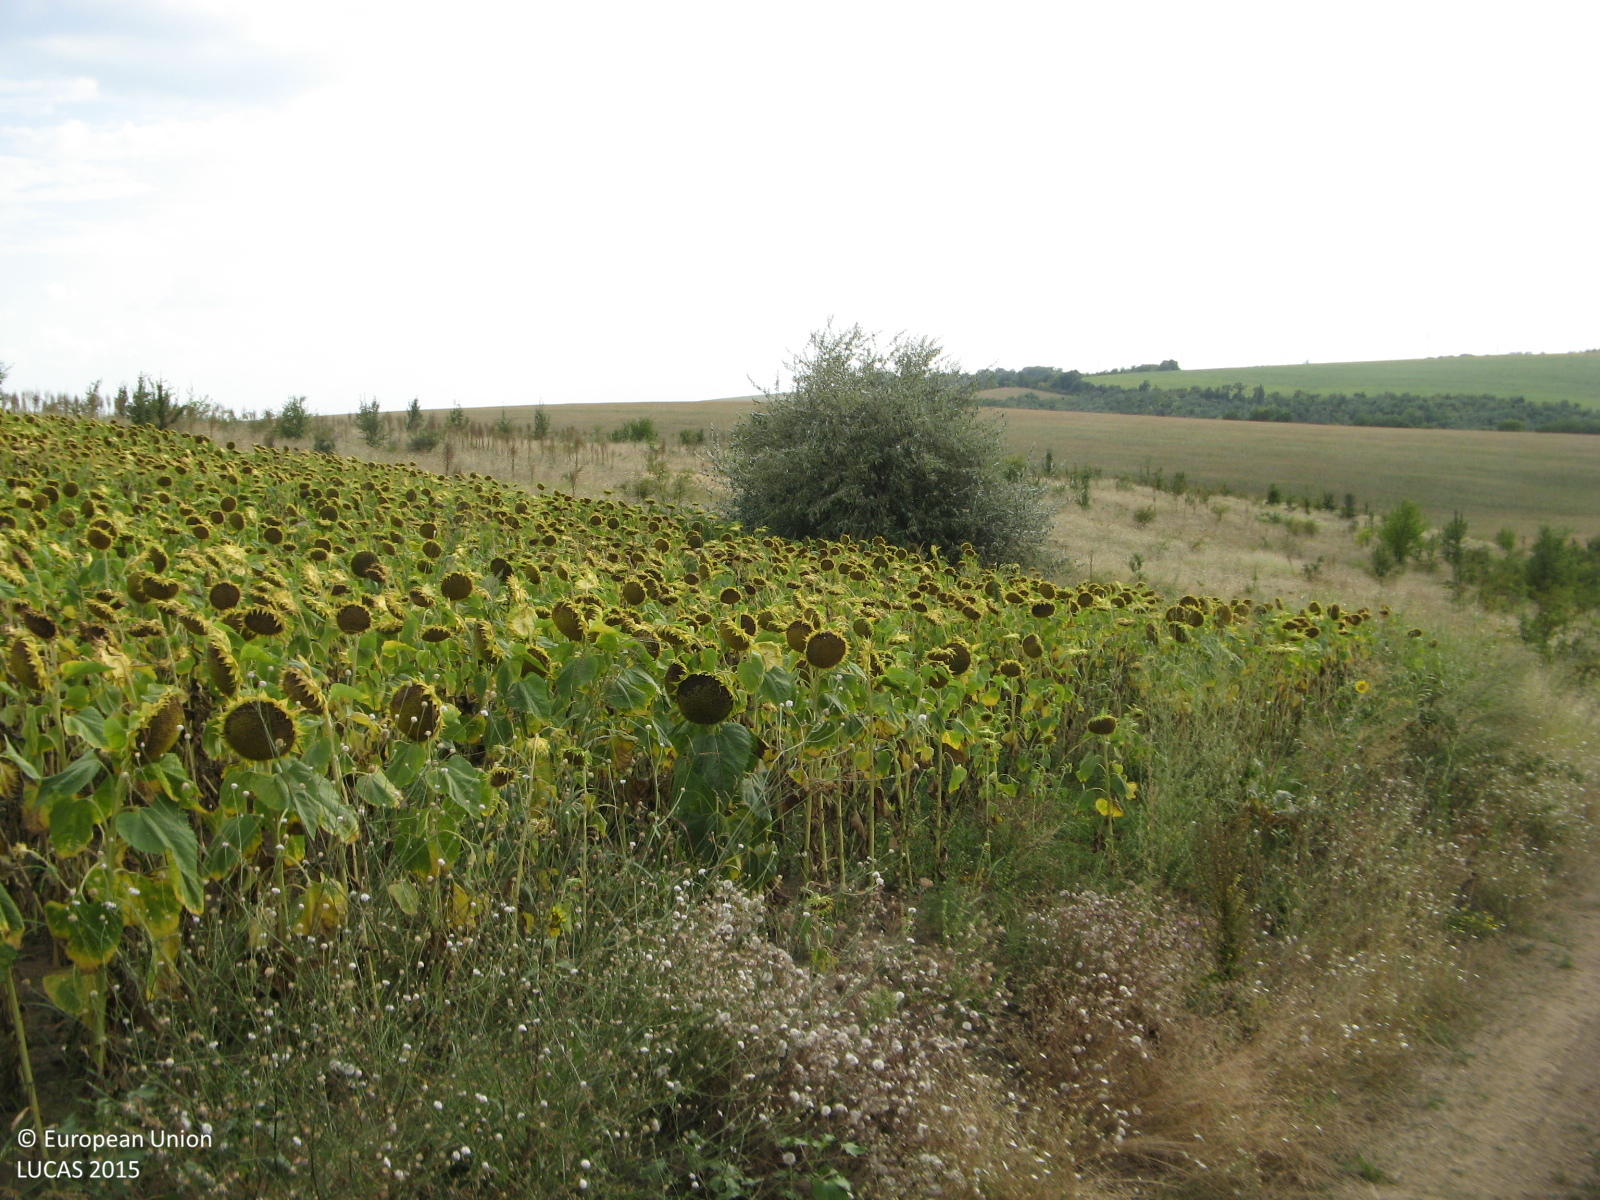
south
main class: Cropland
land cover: Maize
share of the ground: > 75 %
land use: Agriculture (excluding fallow land and kitchen gardens)
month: August
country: BG
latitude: 43.6652
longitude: 25.9040
